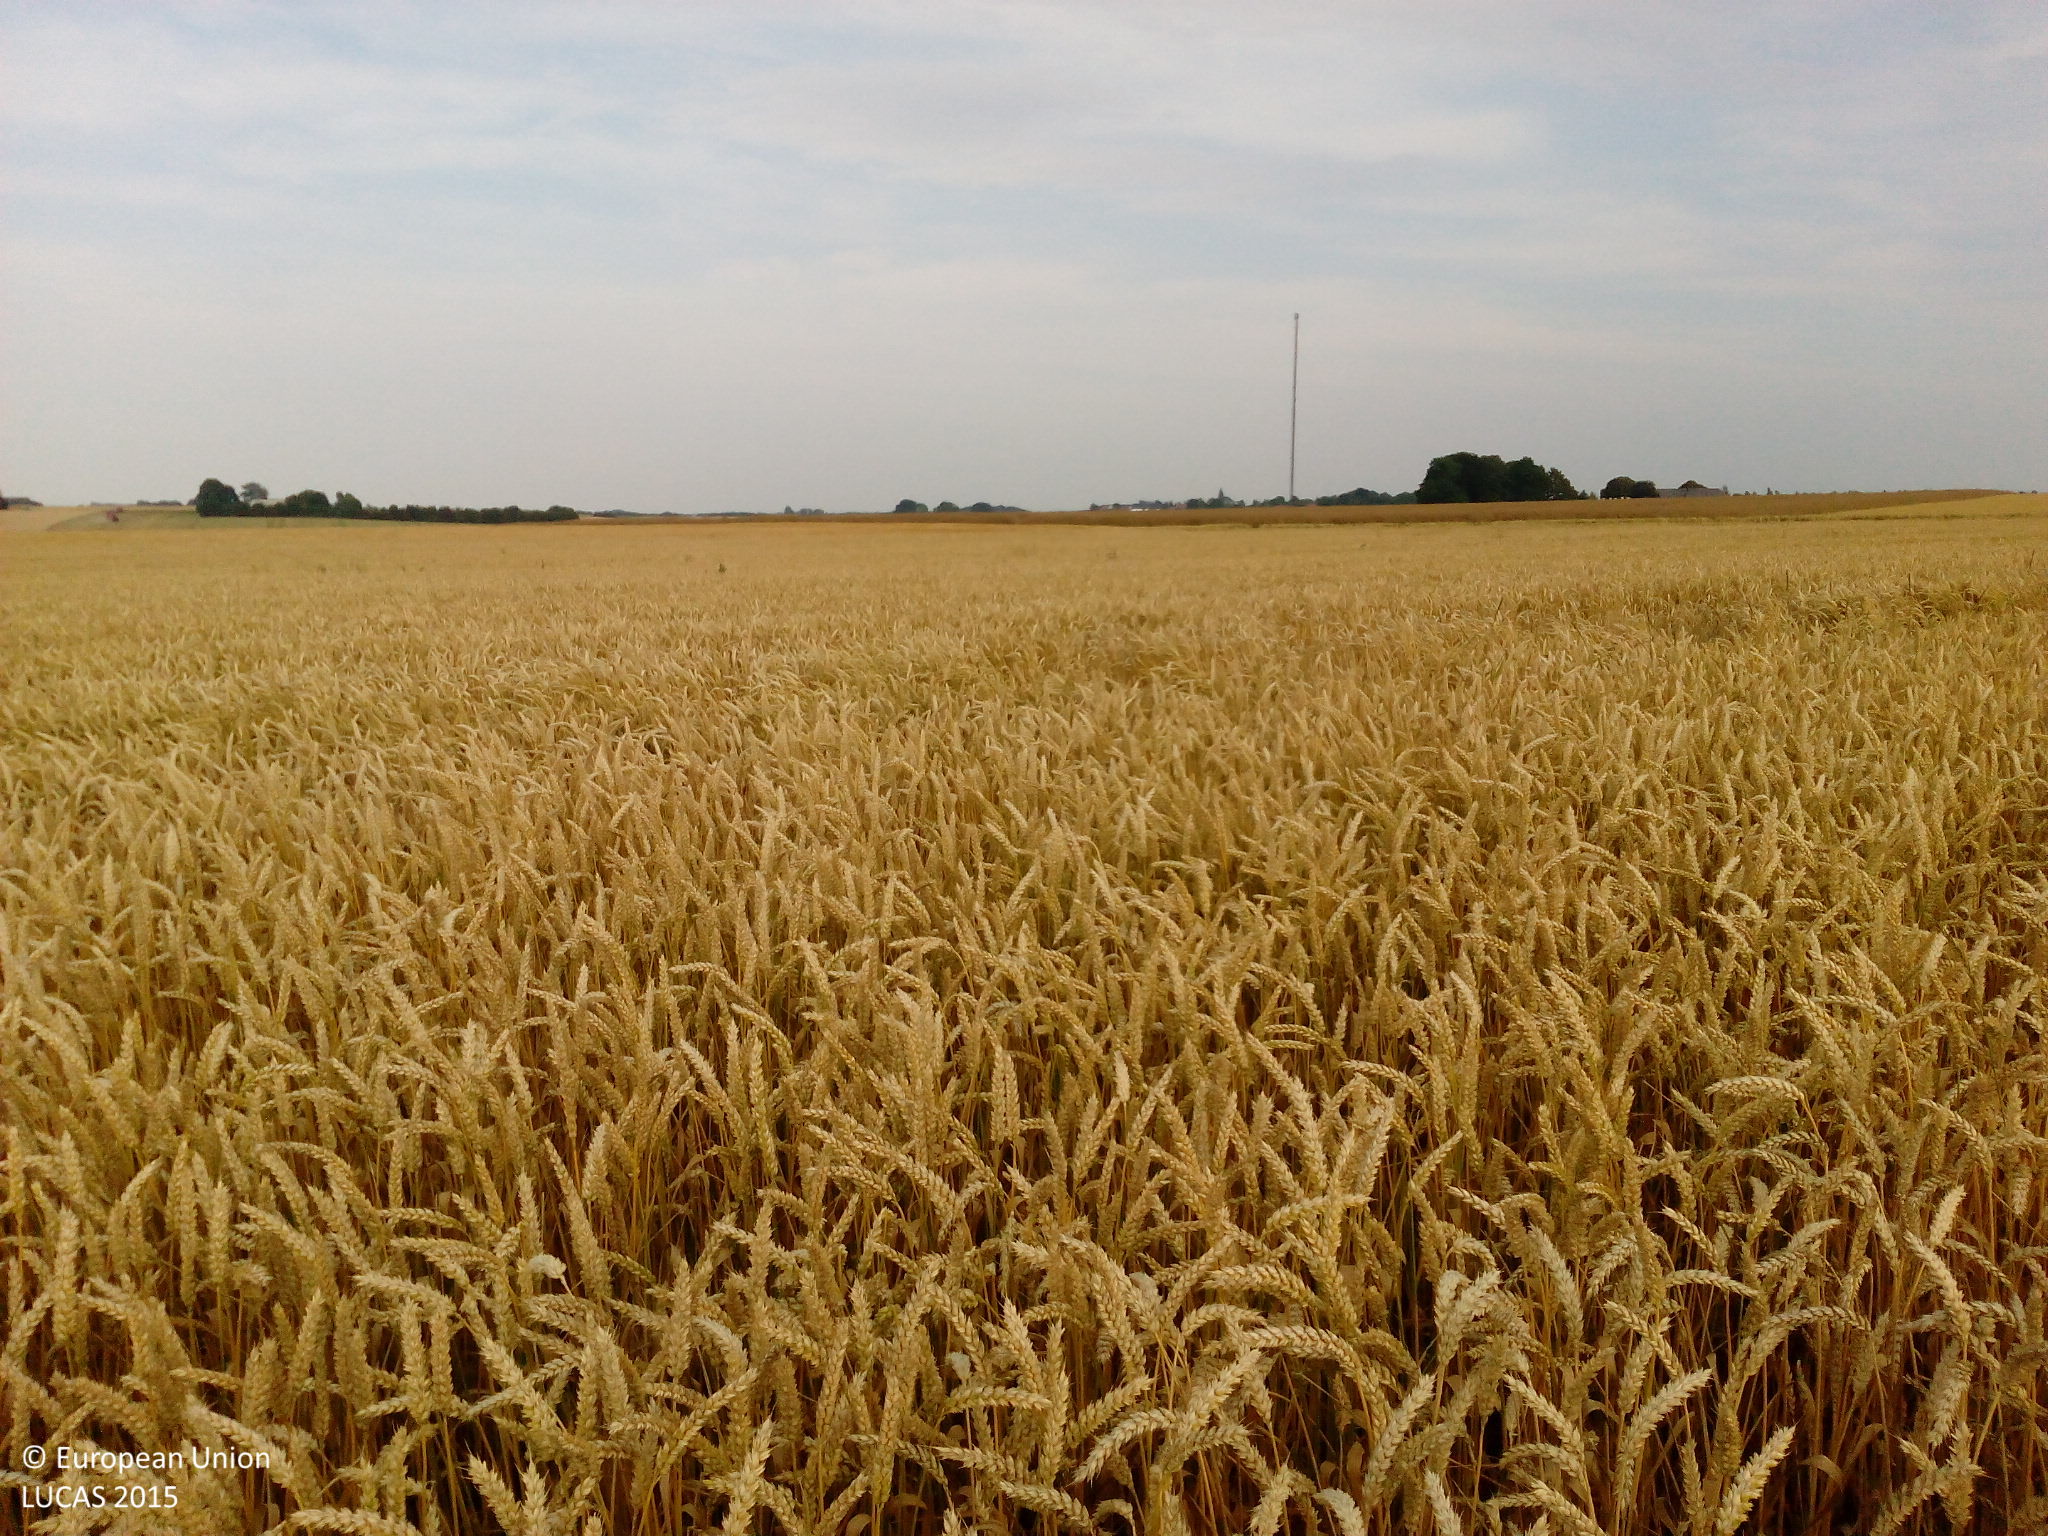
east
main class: Cropland
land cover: Common wheat
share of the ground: > 75 %
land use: Agriculture (excluding fallow land and kitchen gardens)
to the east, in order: Common wheat; Barley; Rape and turnip rape
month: August
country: DK
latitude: 55.4741
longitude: 11.7862
